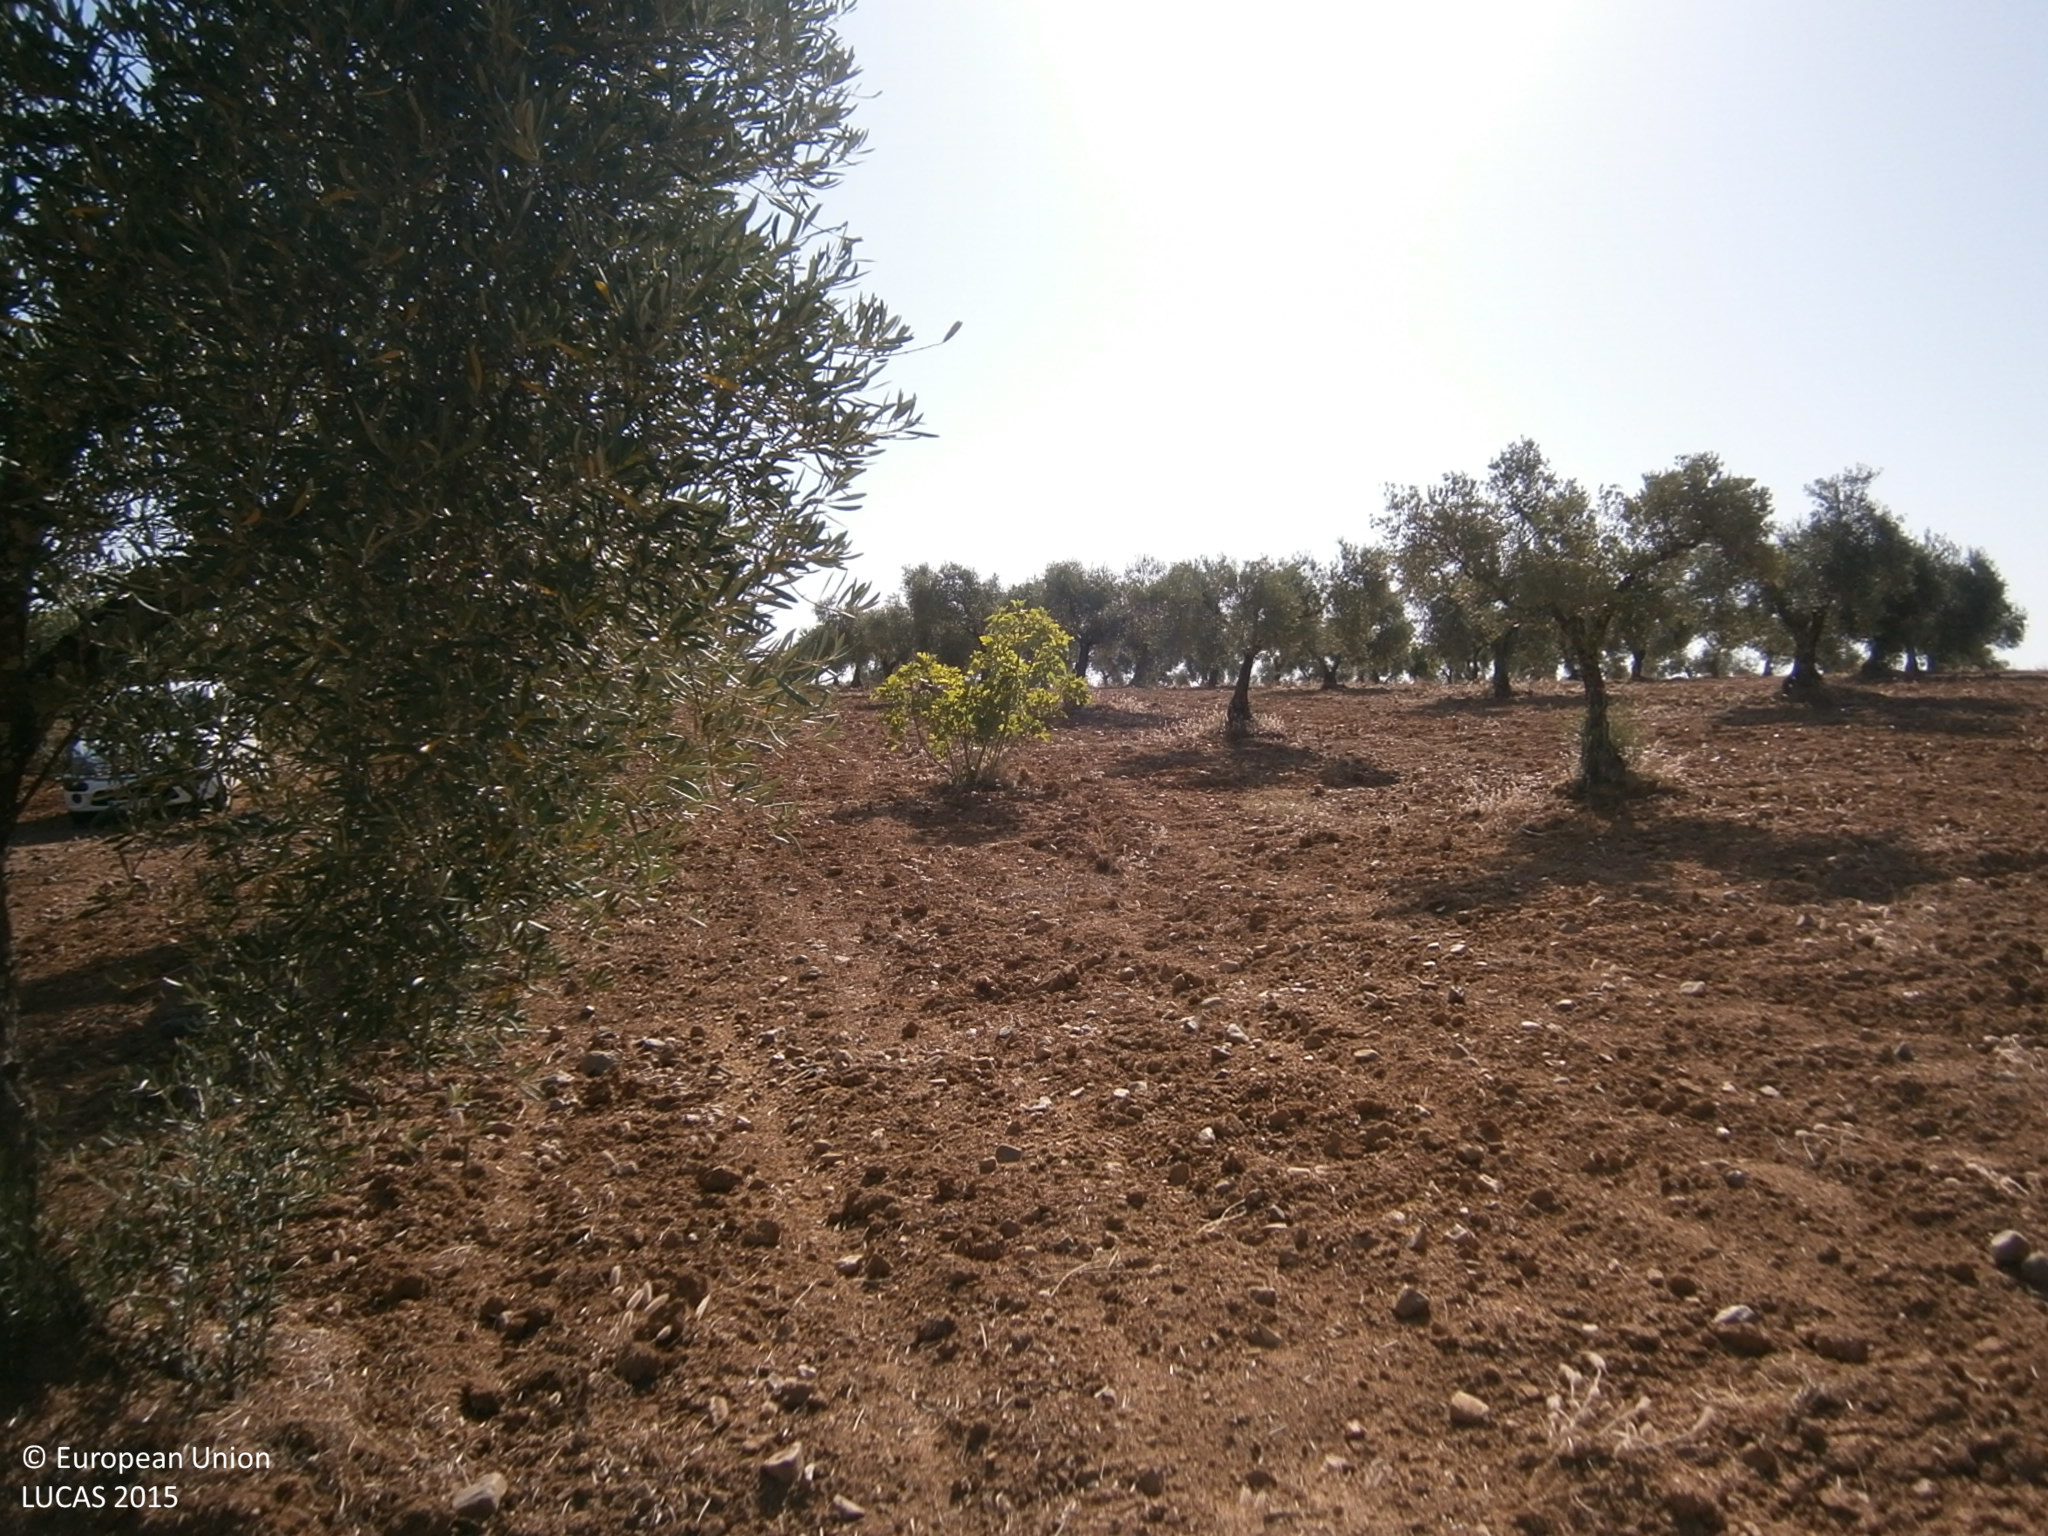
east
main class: Cropland
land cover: Olive groves
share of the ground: 25 - 50 %
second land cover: Other bare soil
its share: > 75 %
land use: Agriculture (excluding fallow land and kitchen gardens)
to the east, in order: Olive groves; Other bare soil; Tracks; Olive groves
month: July
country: ES
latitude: 39.0605
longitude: -6.7208
